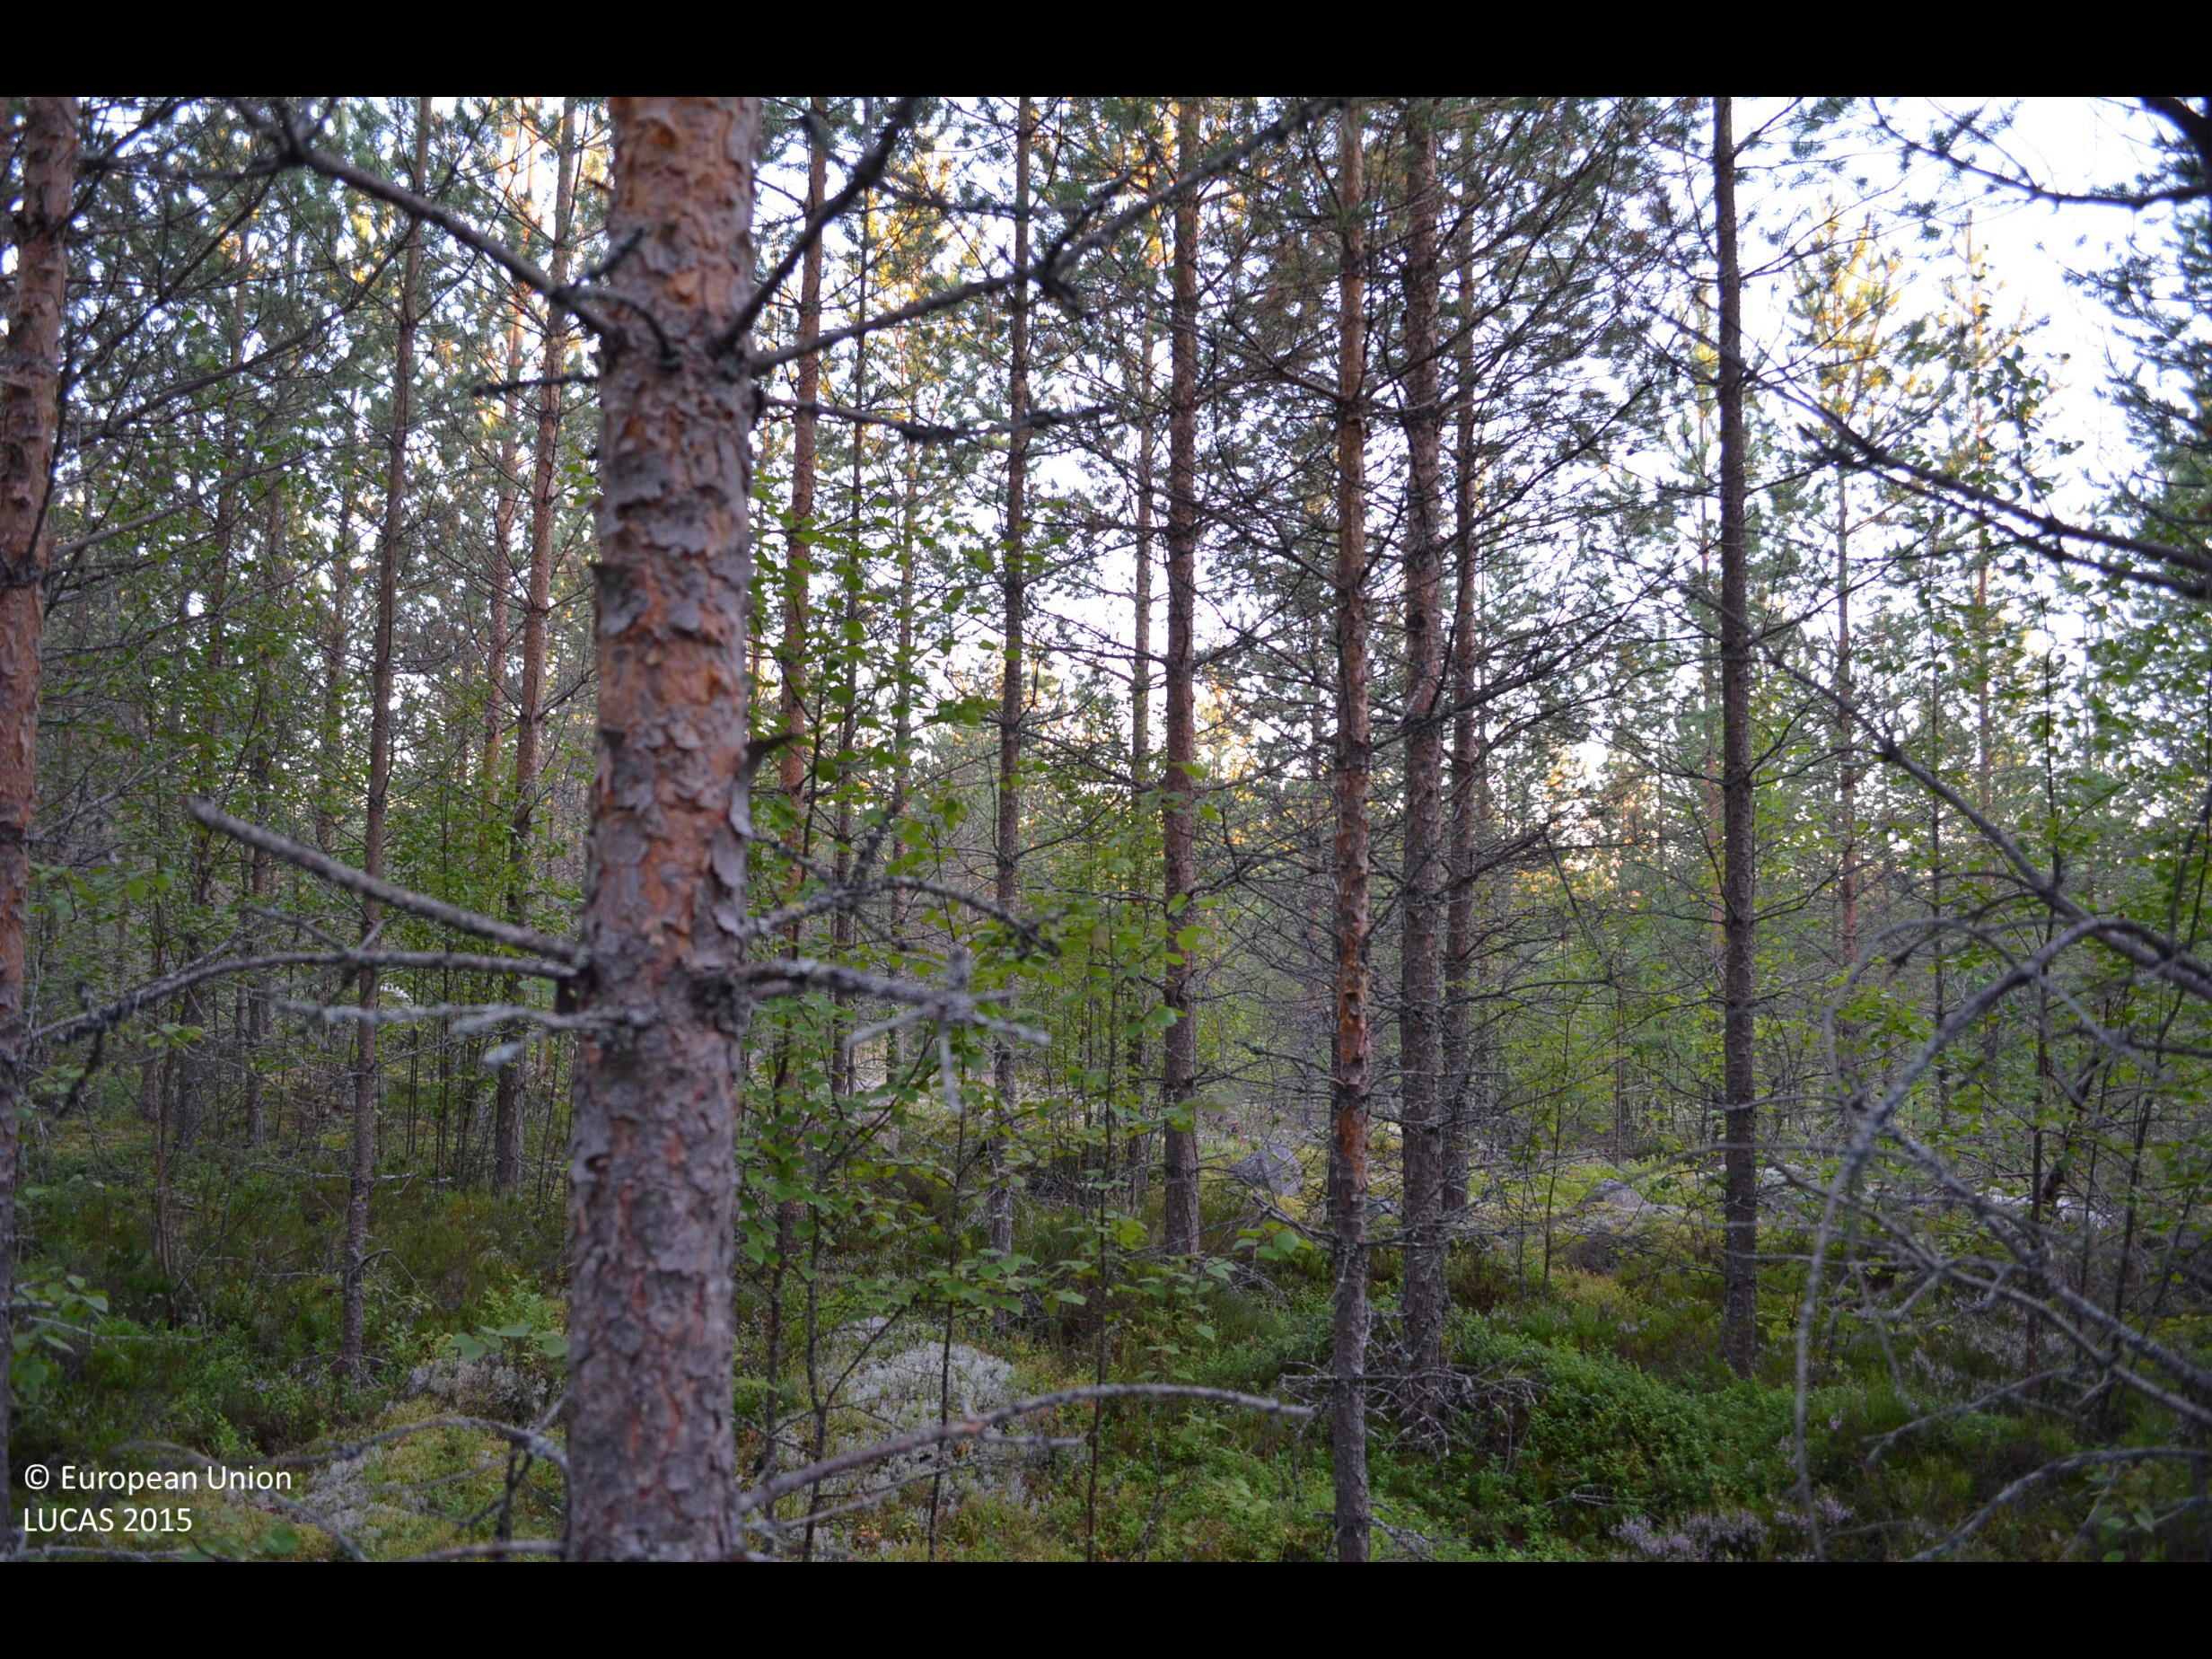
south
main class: Woodland
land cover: Pine dominated coniferous woodland
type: boreal forest
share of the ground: > 75 %
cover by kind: coniferous forest trees 65 %, shrubs 20 %, broadleaved forest trees 15 %
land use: Forestry
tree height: > 5 m
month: August
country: FI
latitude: 62.3735
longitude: 24.4132
